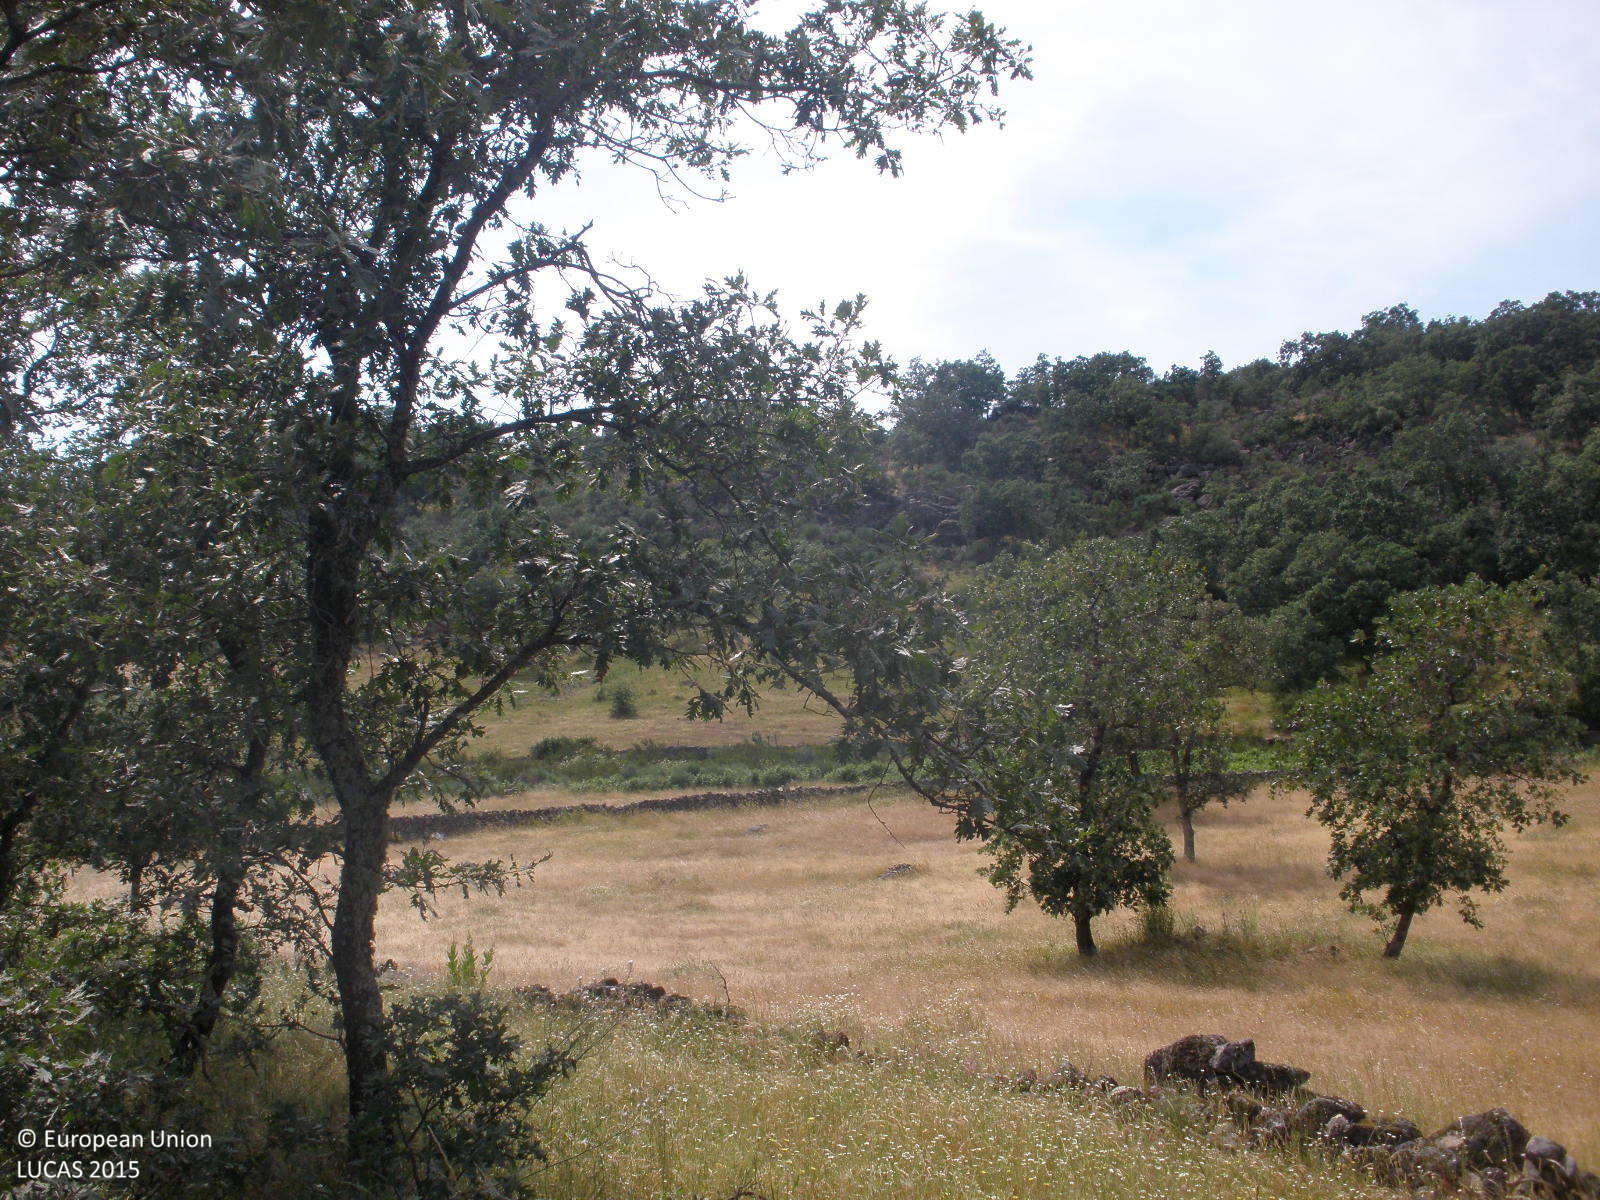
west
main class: Woodland
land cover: Broadleaved woodland
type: thermophilous deciduous forest
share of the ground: 50 - 75 %
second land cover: Grassland without tree/shrub cover
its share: > 75 %
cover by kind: herbaceous plants 50 %, broadleaved forest trees 40 %, consolidated bare surface 10 %
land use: Forestry
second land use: Agriculture (excluding fallow land and kitchen gardens)
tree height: > 5 m
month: May
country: ES
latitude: 40.1715
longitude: -6.5825
